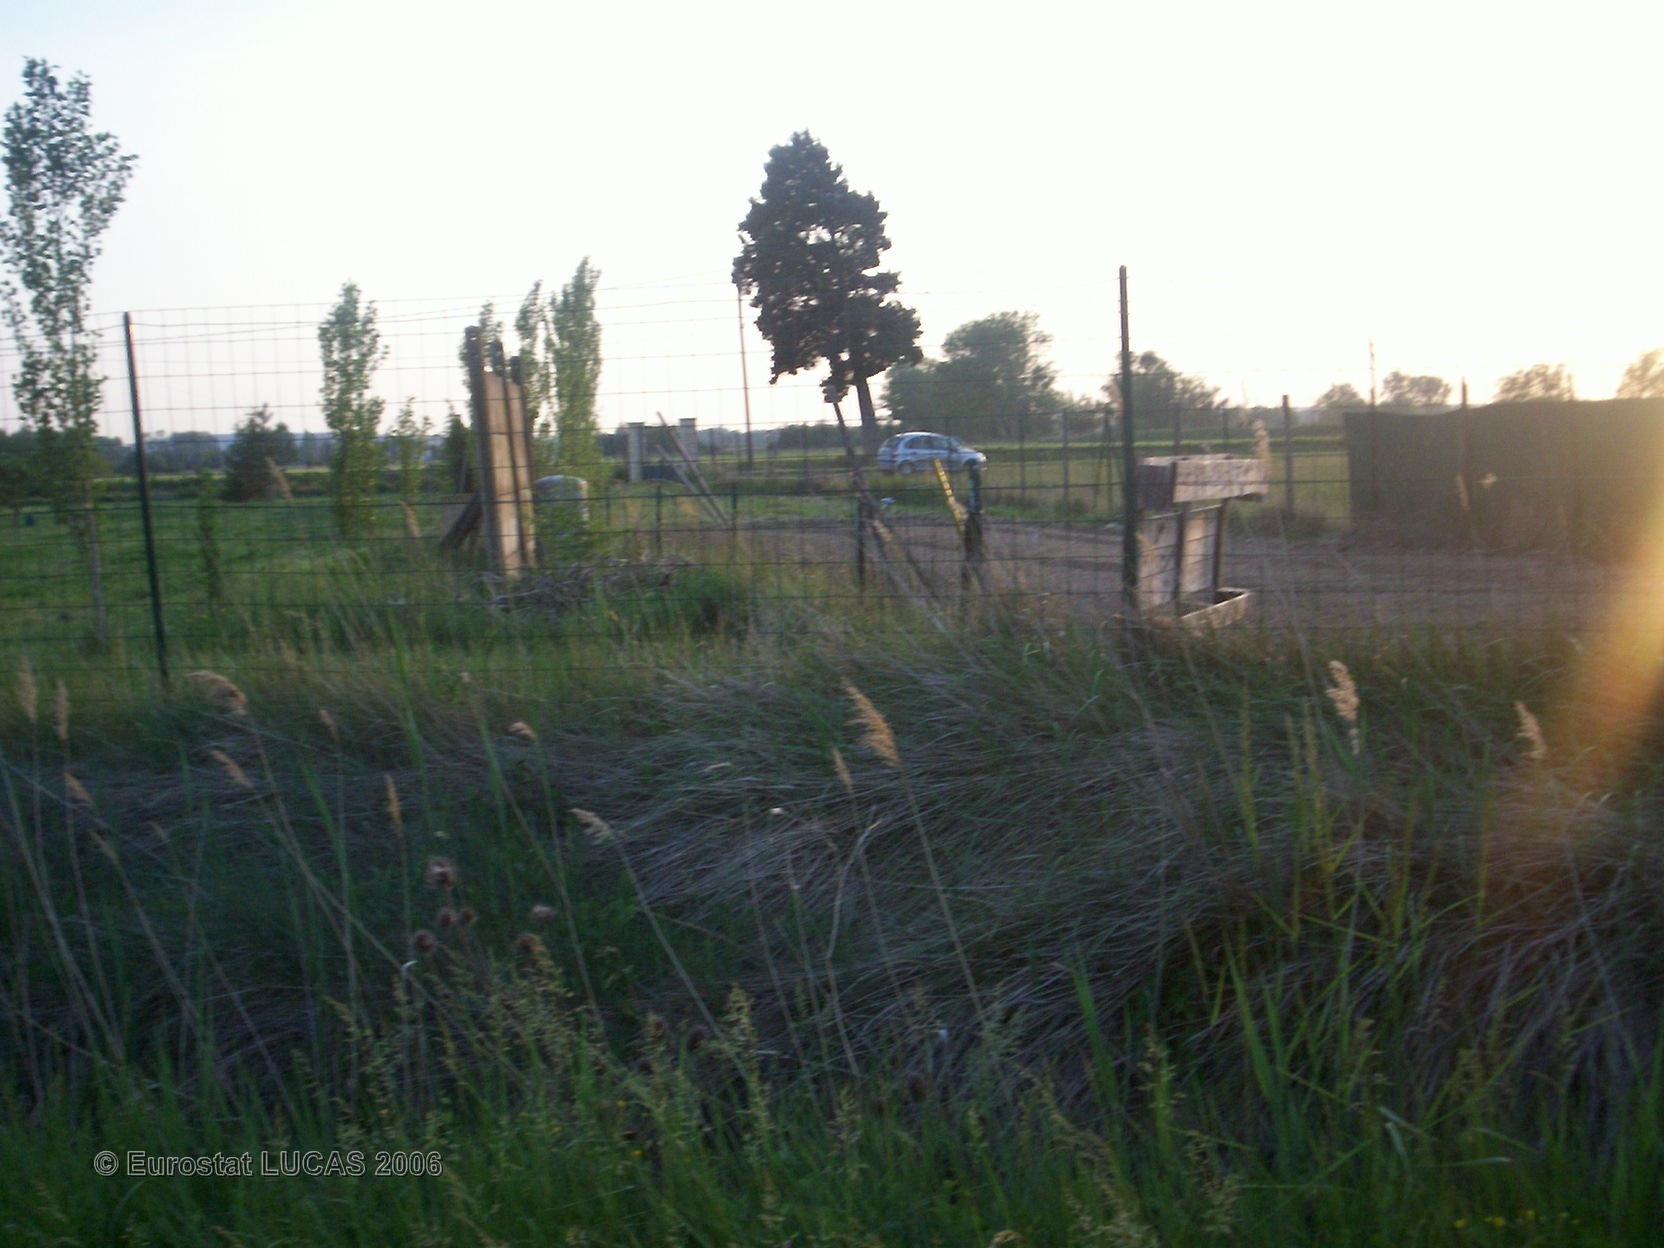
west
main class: Grassland
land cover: Grassland without tree/shrub cover
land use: Agriculture (excluding fallow land and kitchen gardens)
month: May
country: FR
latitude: 44.0471
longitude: 4.9536
